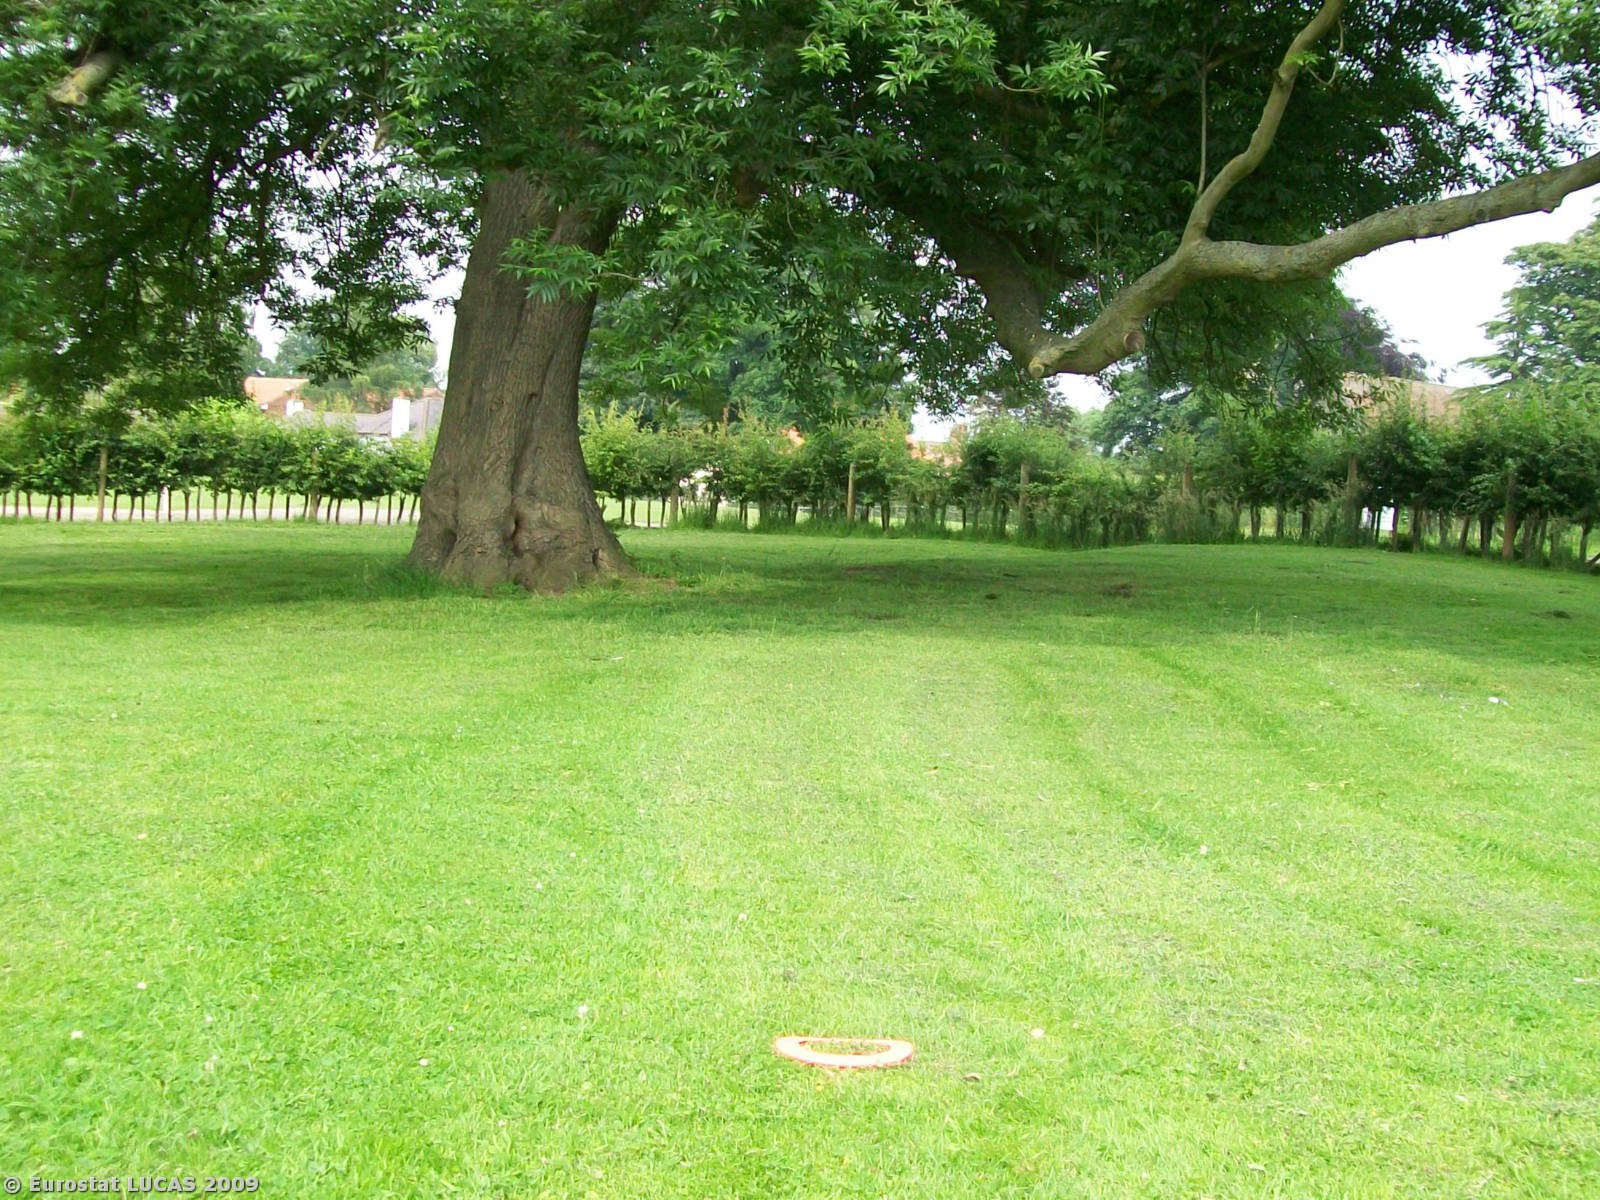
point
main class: Grassland
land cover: Grassland with sparse tree/shrub cover
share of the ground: < 10 %
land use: Holiday camps
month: June
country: GB
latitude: 54.0875
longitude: -1.4997
